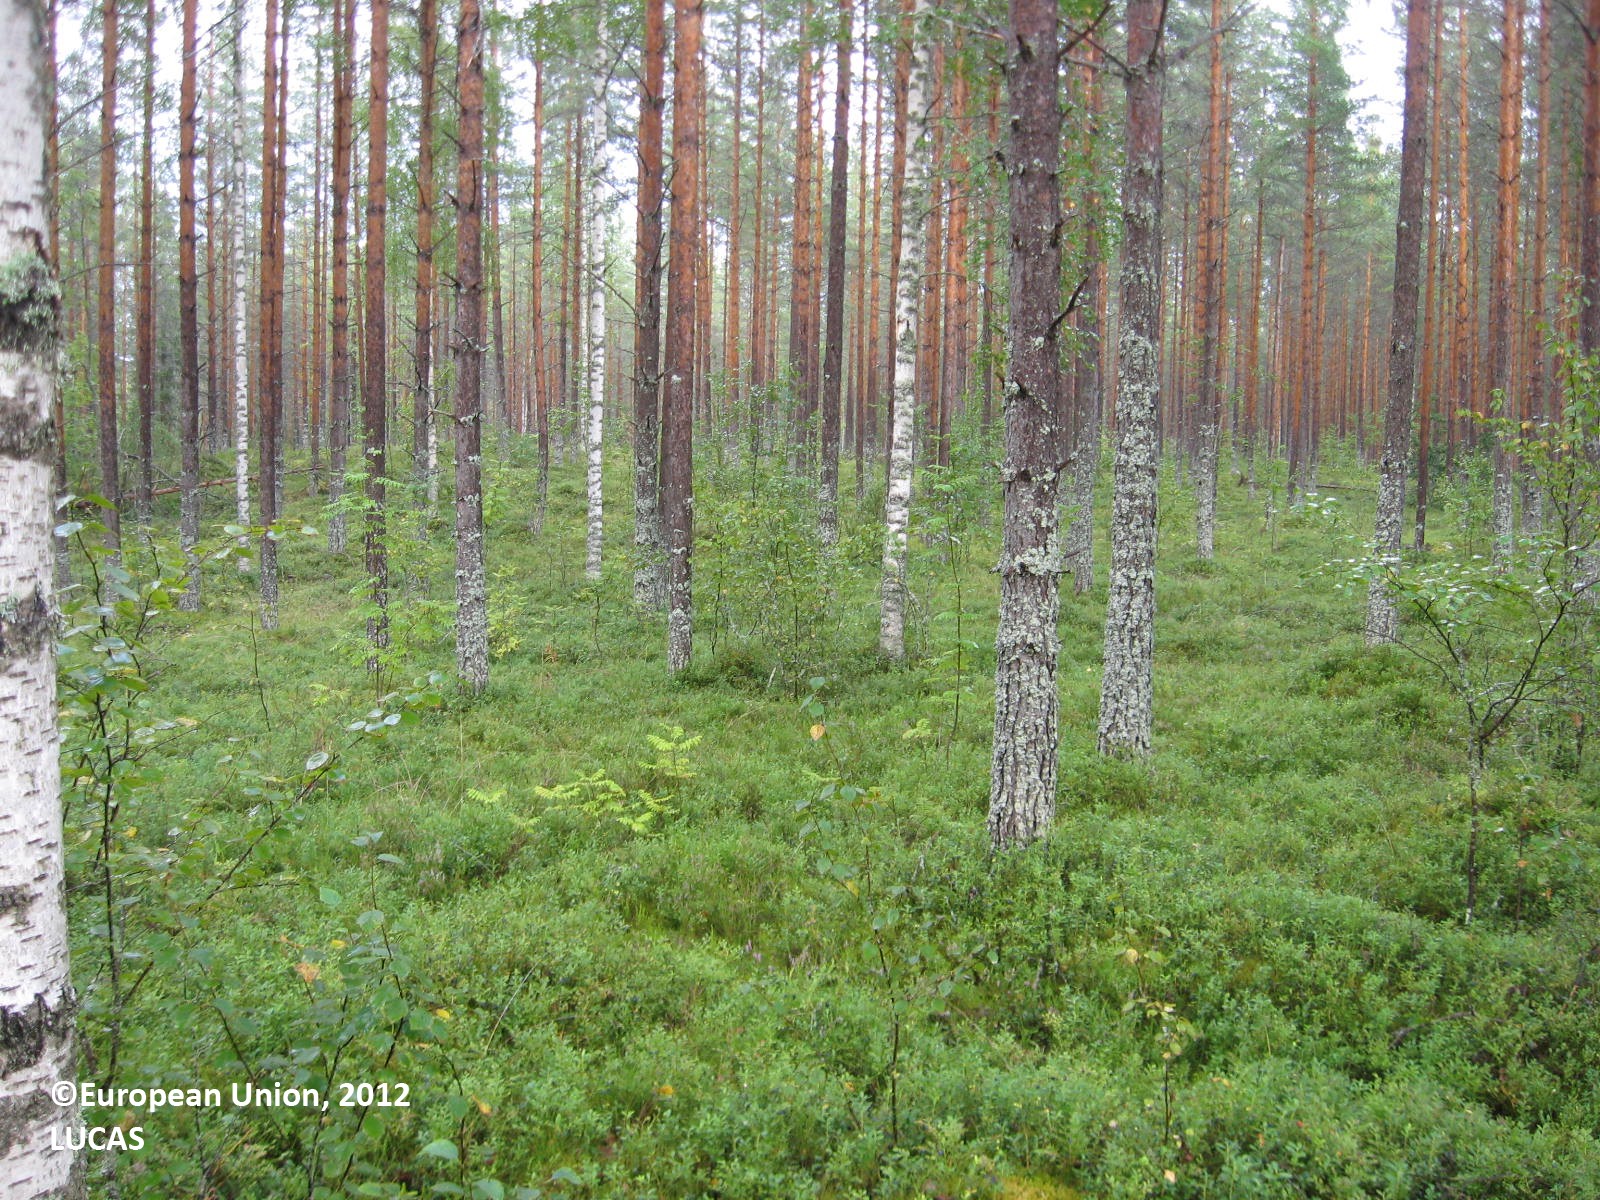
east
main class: Woodland
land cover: Pine dominated coniferous woodland
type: boreal forest
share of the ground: > 75 %
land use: Forestry
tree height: > 5 m
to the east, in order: Pine dominated coniferous woodland; Pine dominated mixed woodland
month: August
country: FI
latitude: 63.4404
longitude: 30.4130
